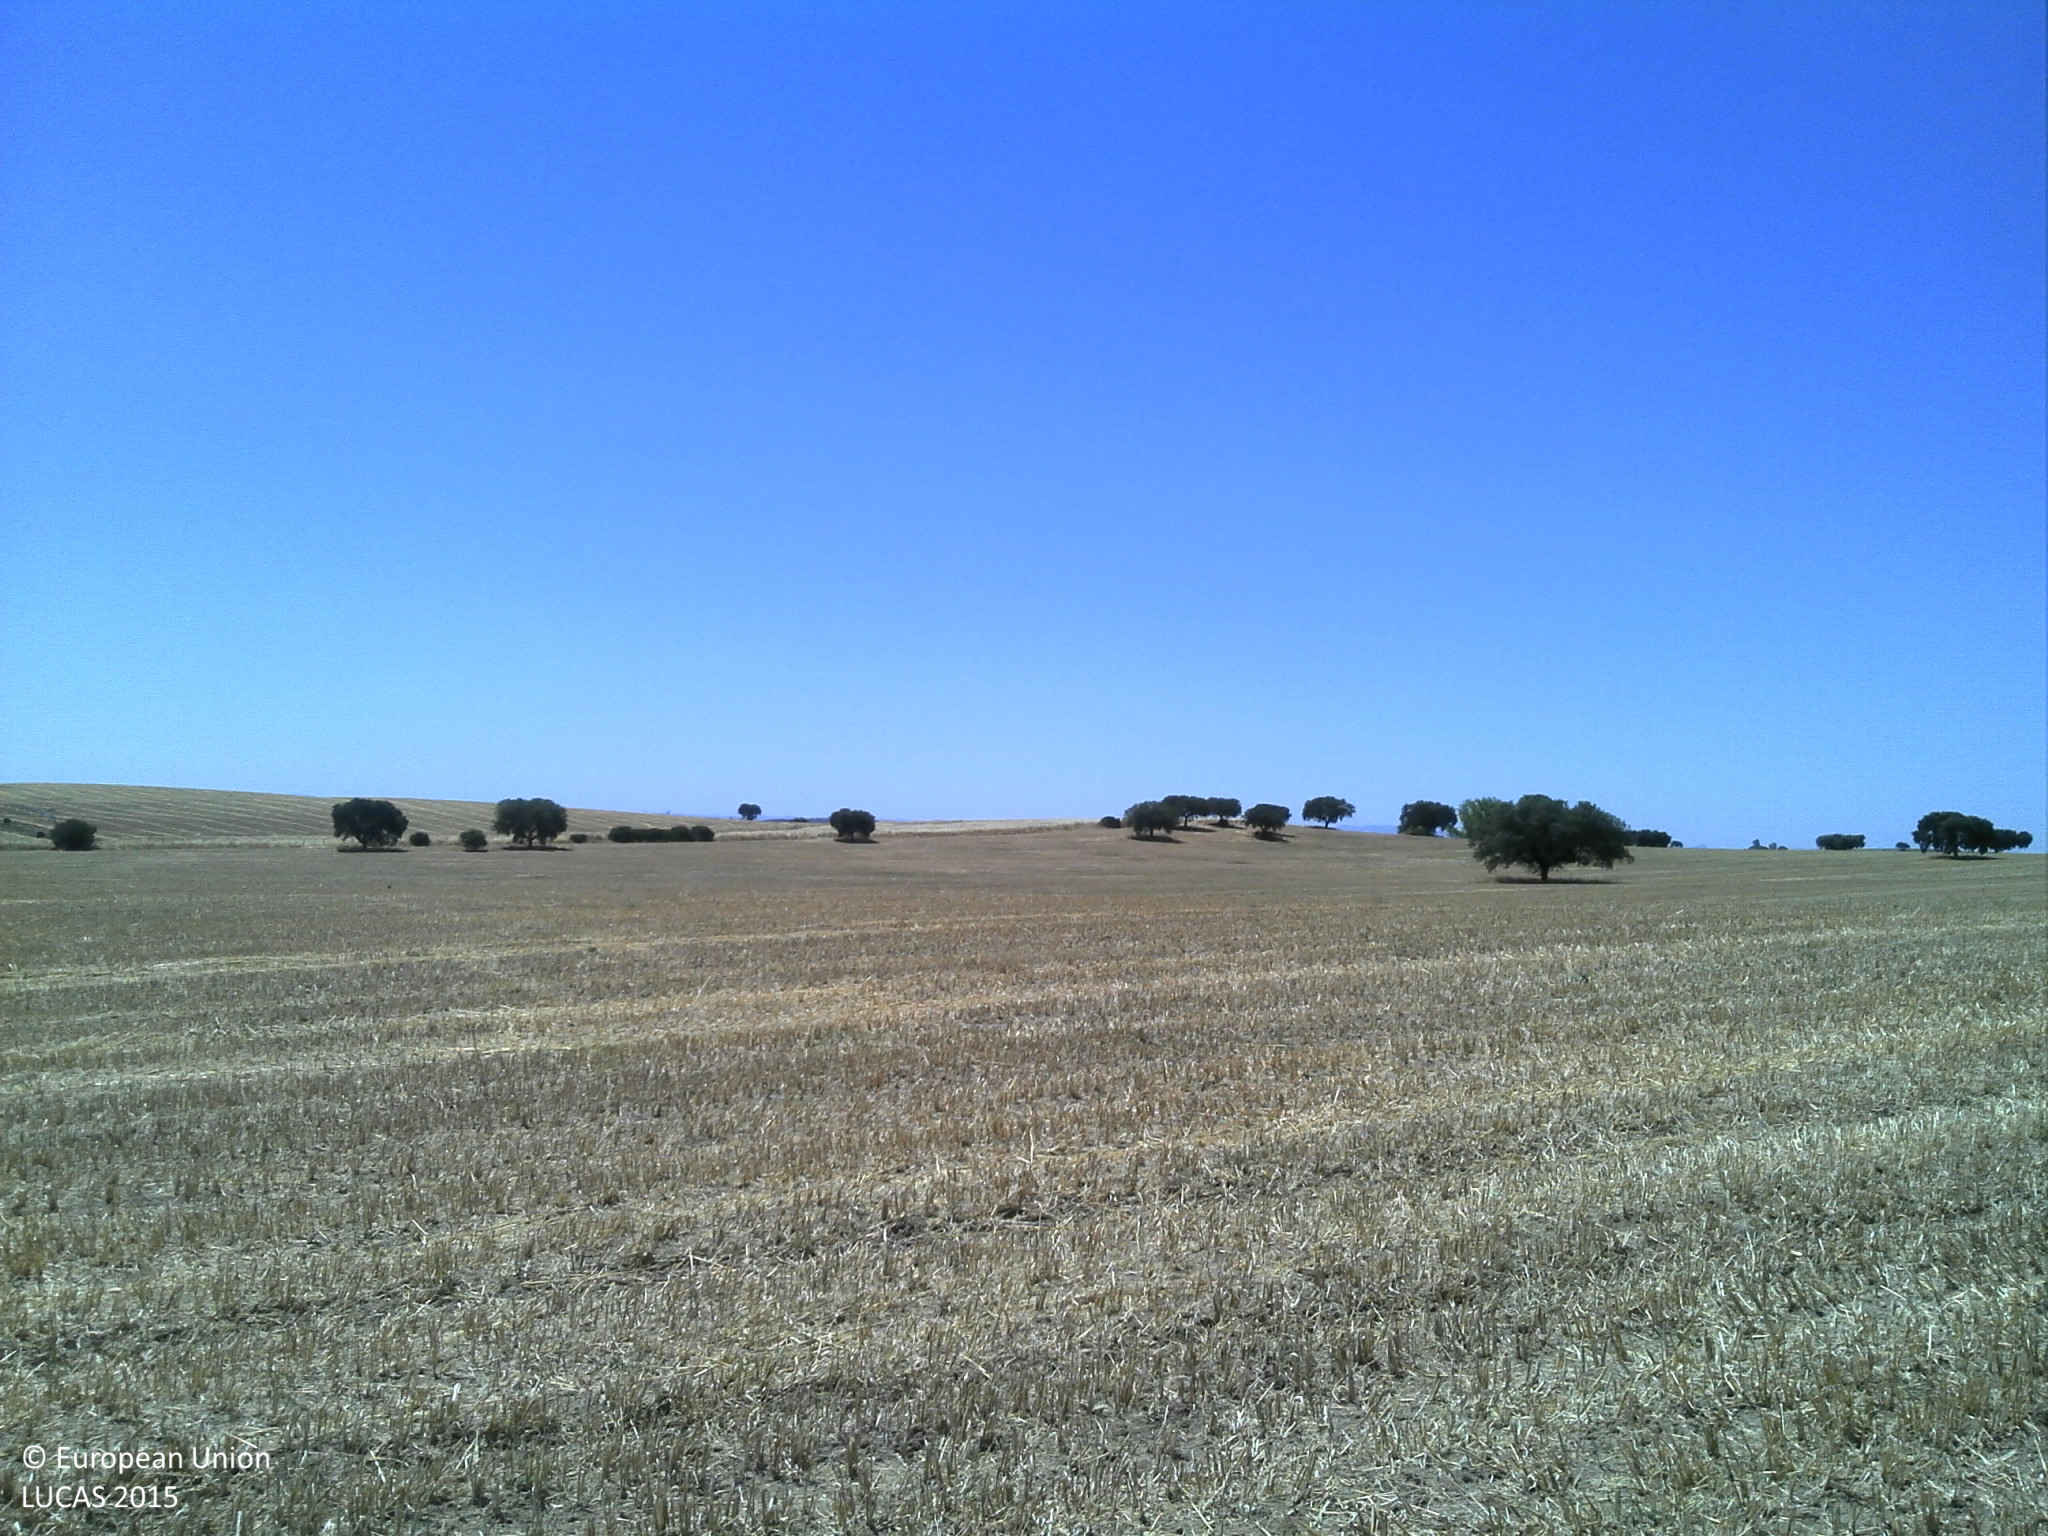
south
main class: Cropland
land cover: Oats
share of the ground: < 10 %
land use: Agriculture (excluding fallow land and kitchen gardens)
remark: Harvested field
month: July
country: PT
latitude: 38.9734
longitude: -7.0050
